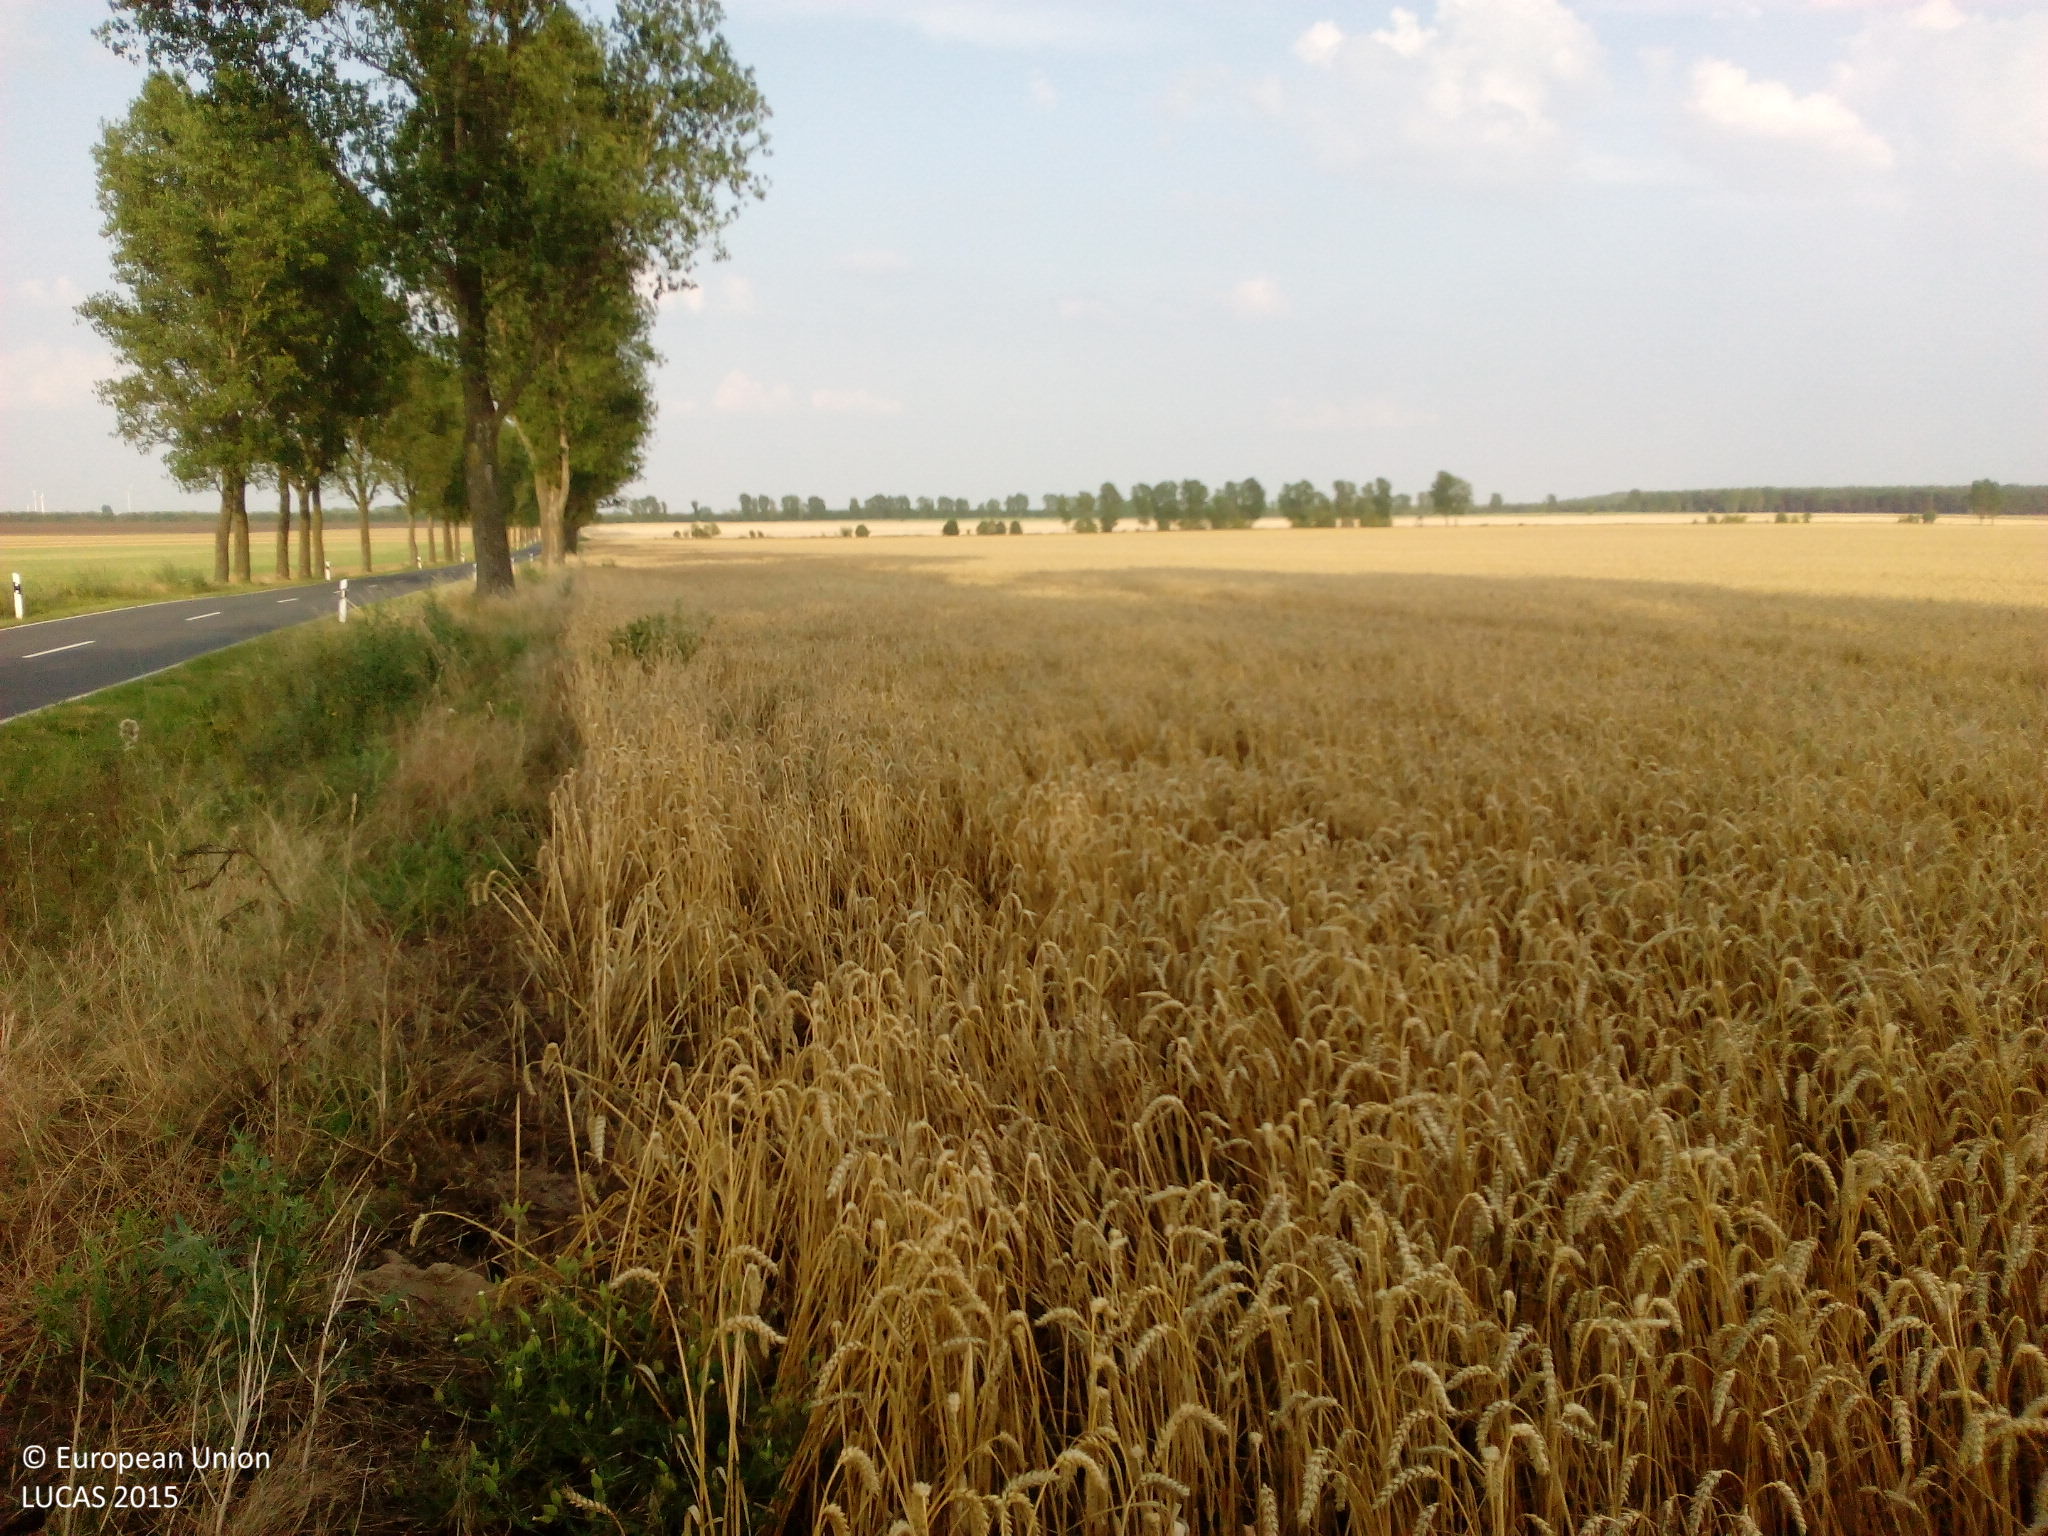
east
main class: Cropland
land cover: Common wheat
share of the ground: > 75 %
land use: Agriculture (excluding fallow land and kitchen gardens)
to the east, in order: Common wheat
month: August
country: DE
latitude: 51.9039
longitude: 13.1541
